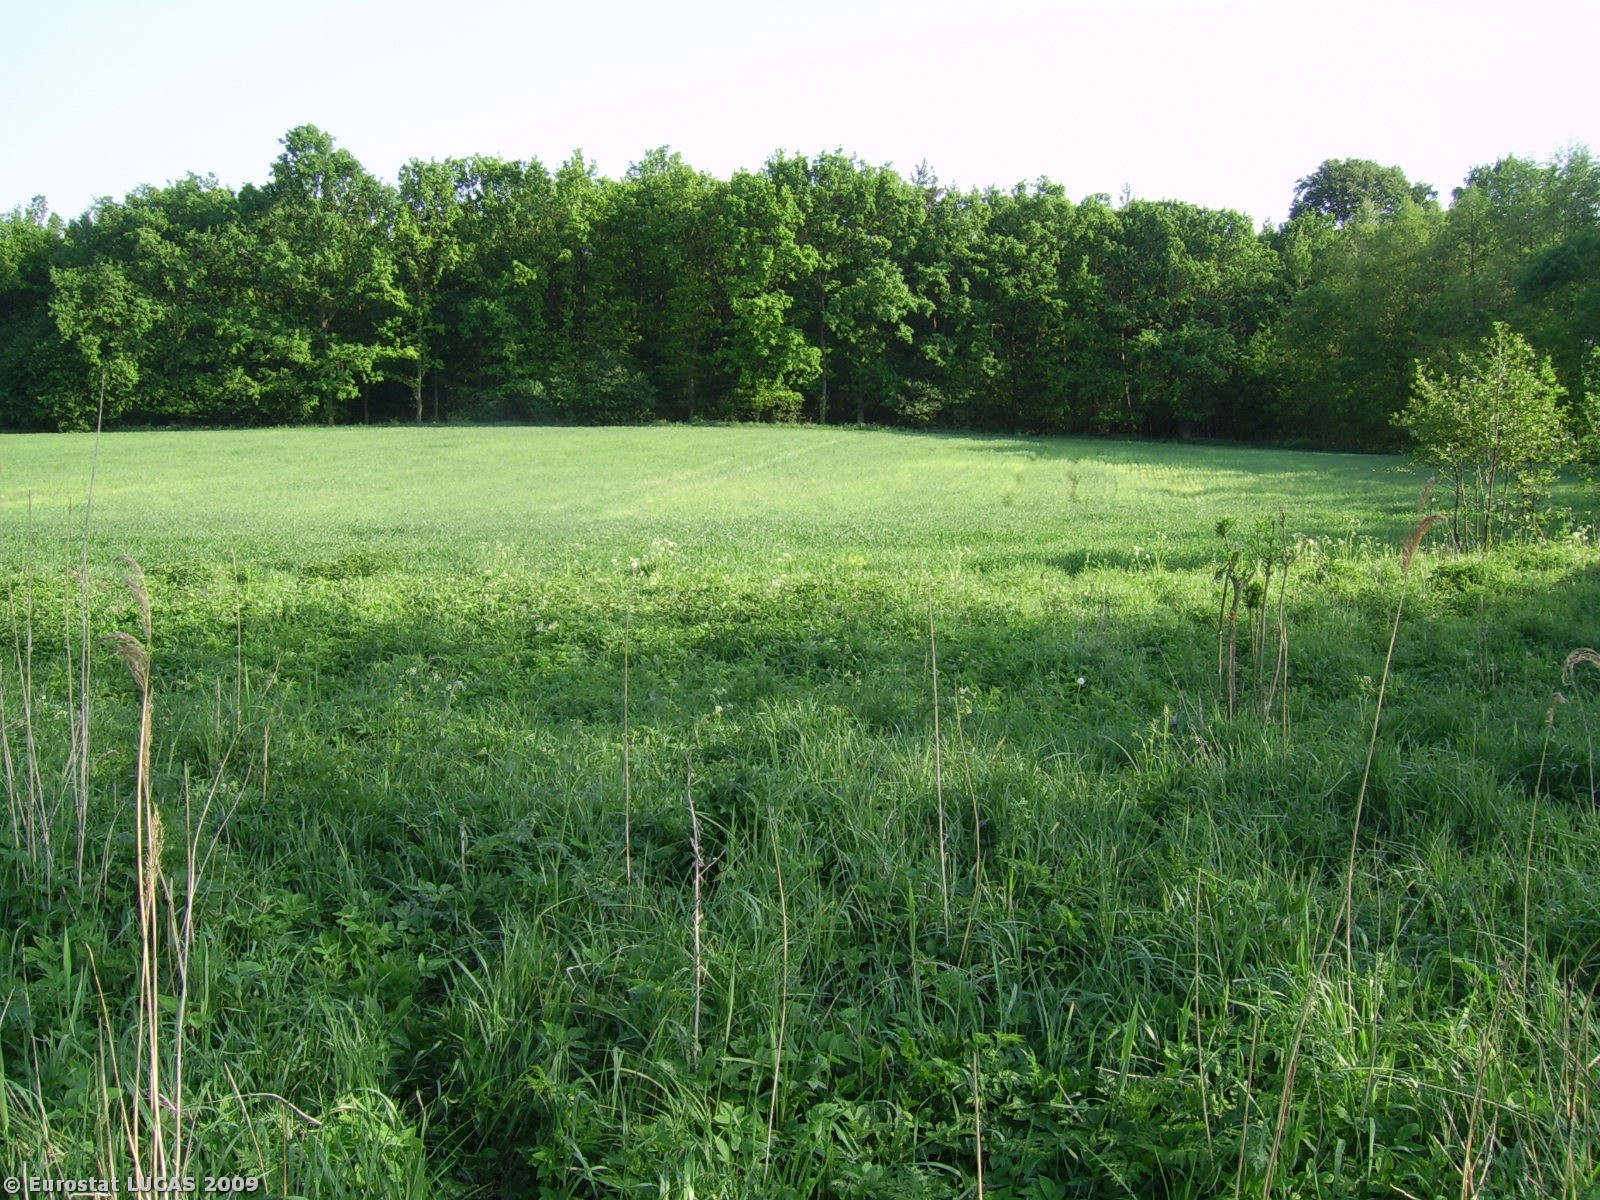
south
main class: Cropland
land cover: Rye
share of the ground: > 75 %
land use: Agriculture (excluding fallow land and kitchen gardens)
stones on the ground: < 10 %
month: May
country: PL
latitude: 52.9612
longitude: 17.6502
